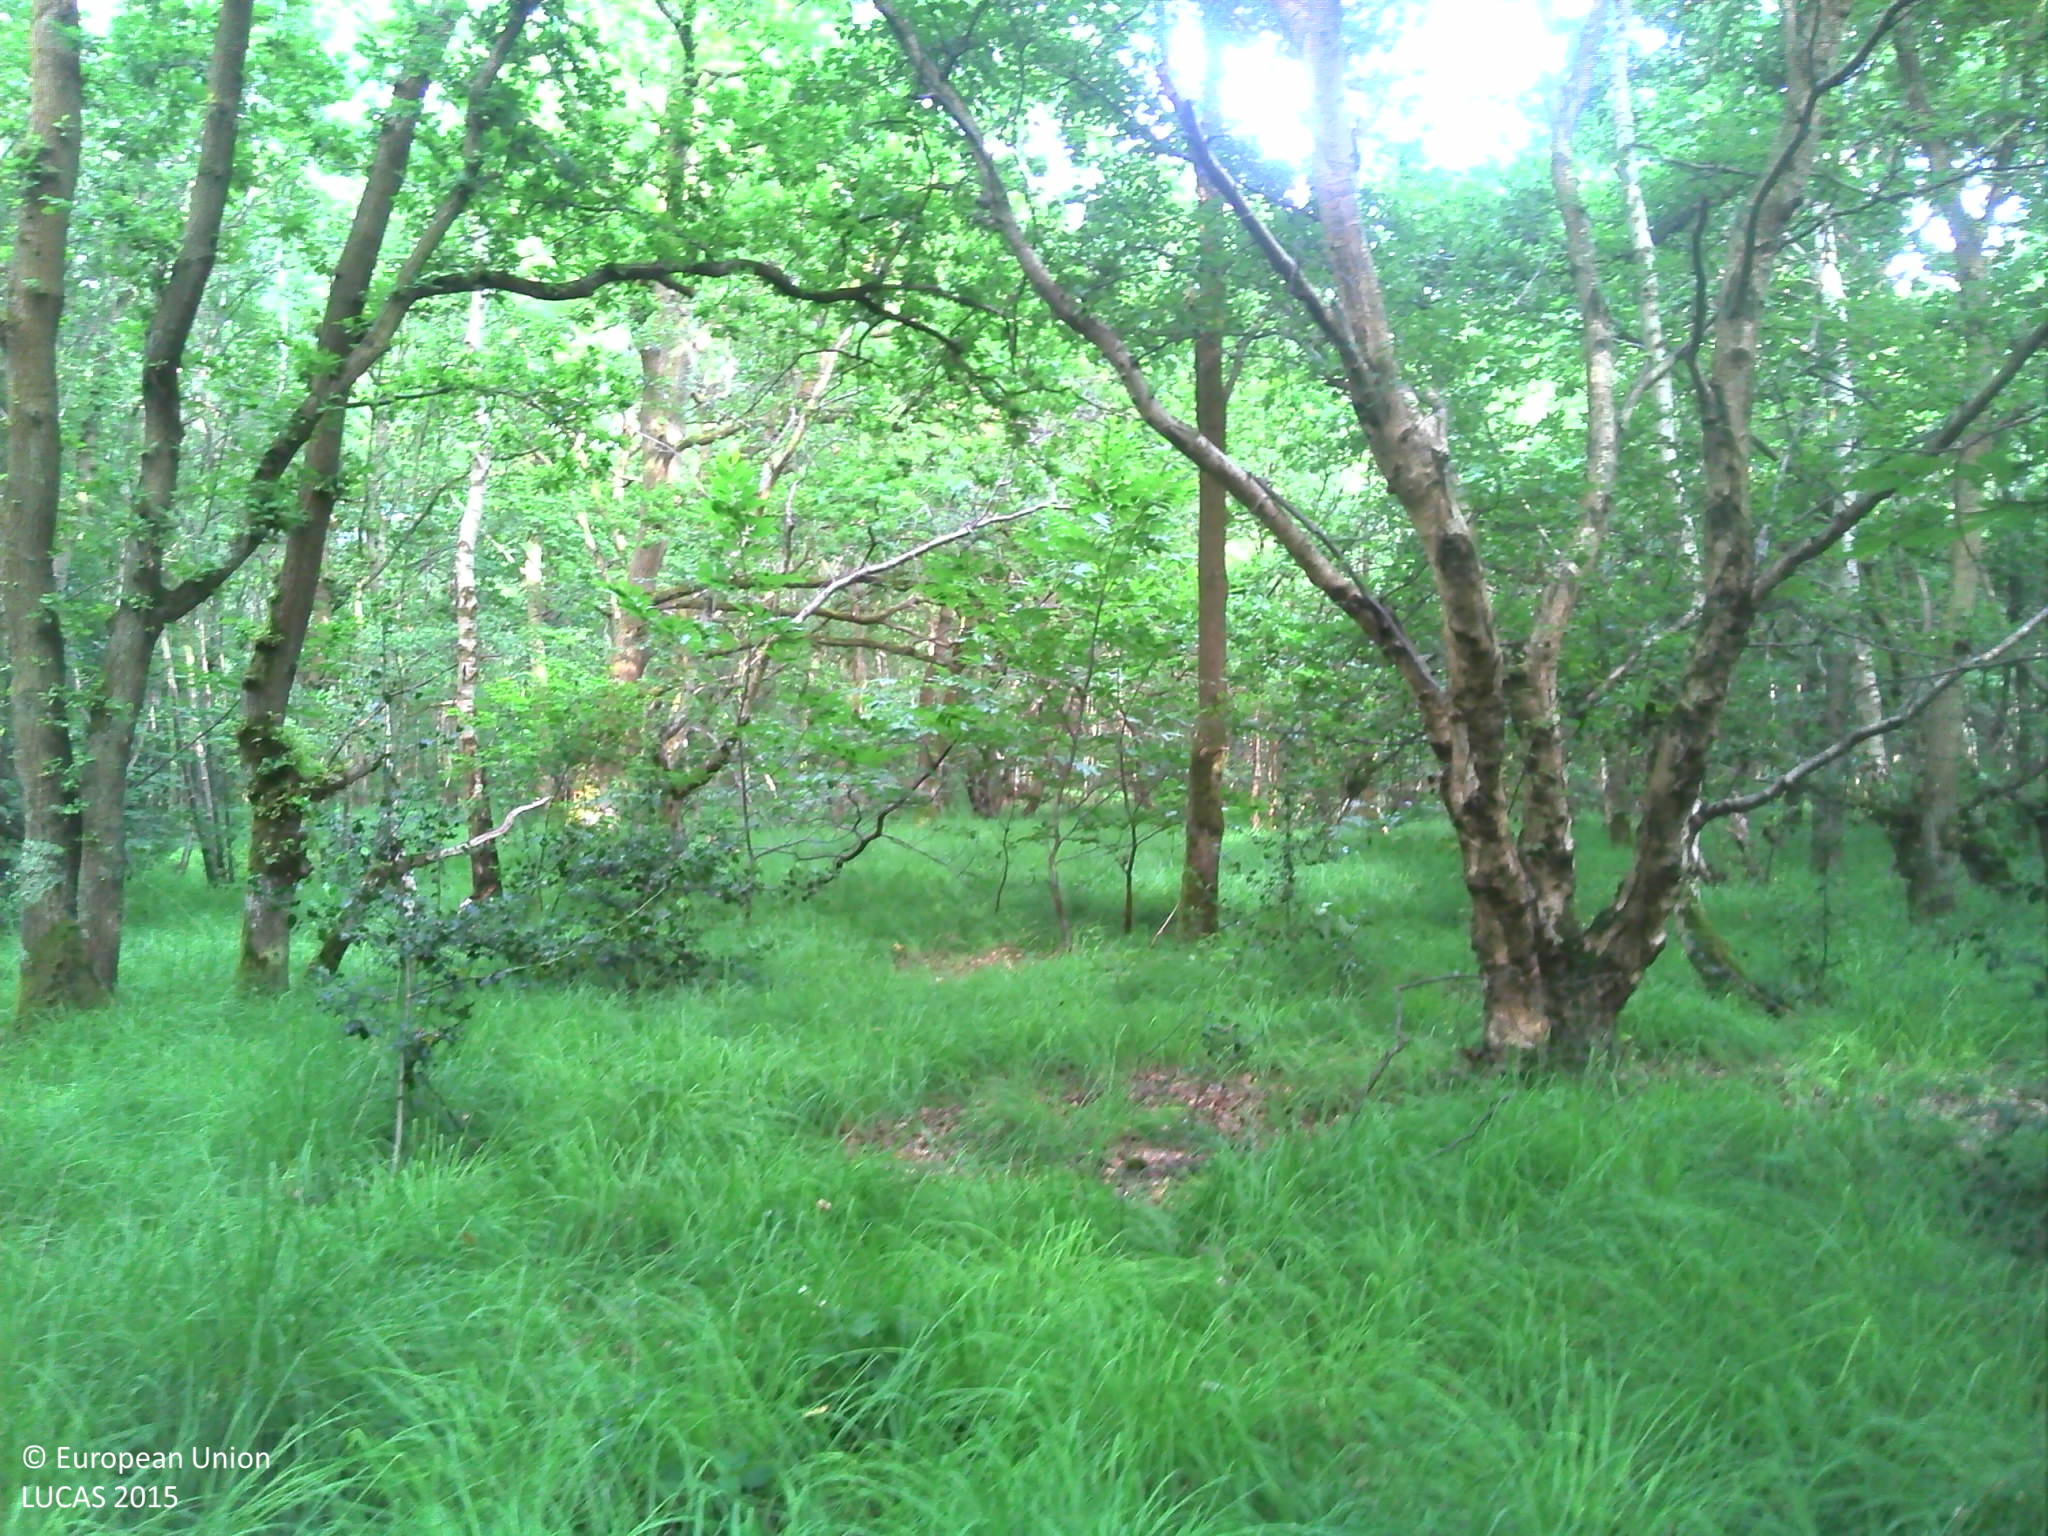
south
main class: Woodland
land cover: Broadleaved woodland
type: mesophytic deciduous forest
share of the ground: 25 - 50 %
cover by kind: herbaceous plants 60 %, broadleaved forest trees 40 %
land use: Forestry
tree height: > 5 m
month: July
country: FR
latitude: 49.4130
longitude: 0.3651
